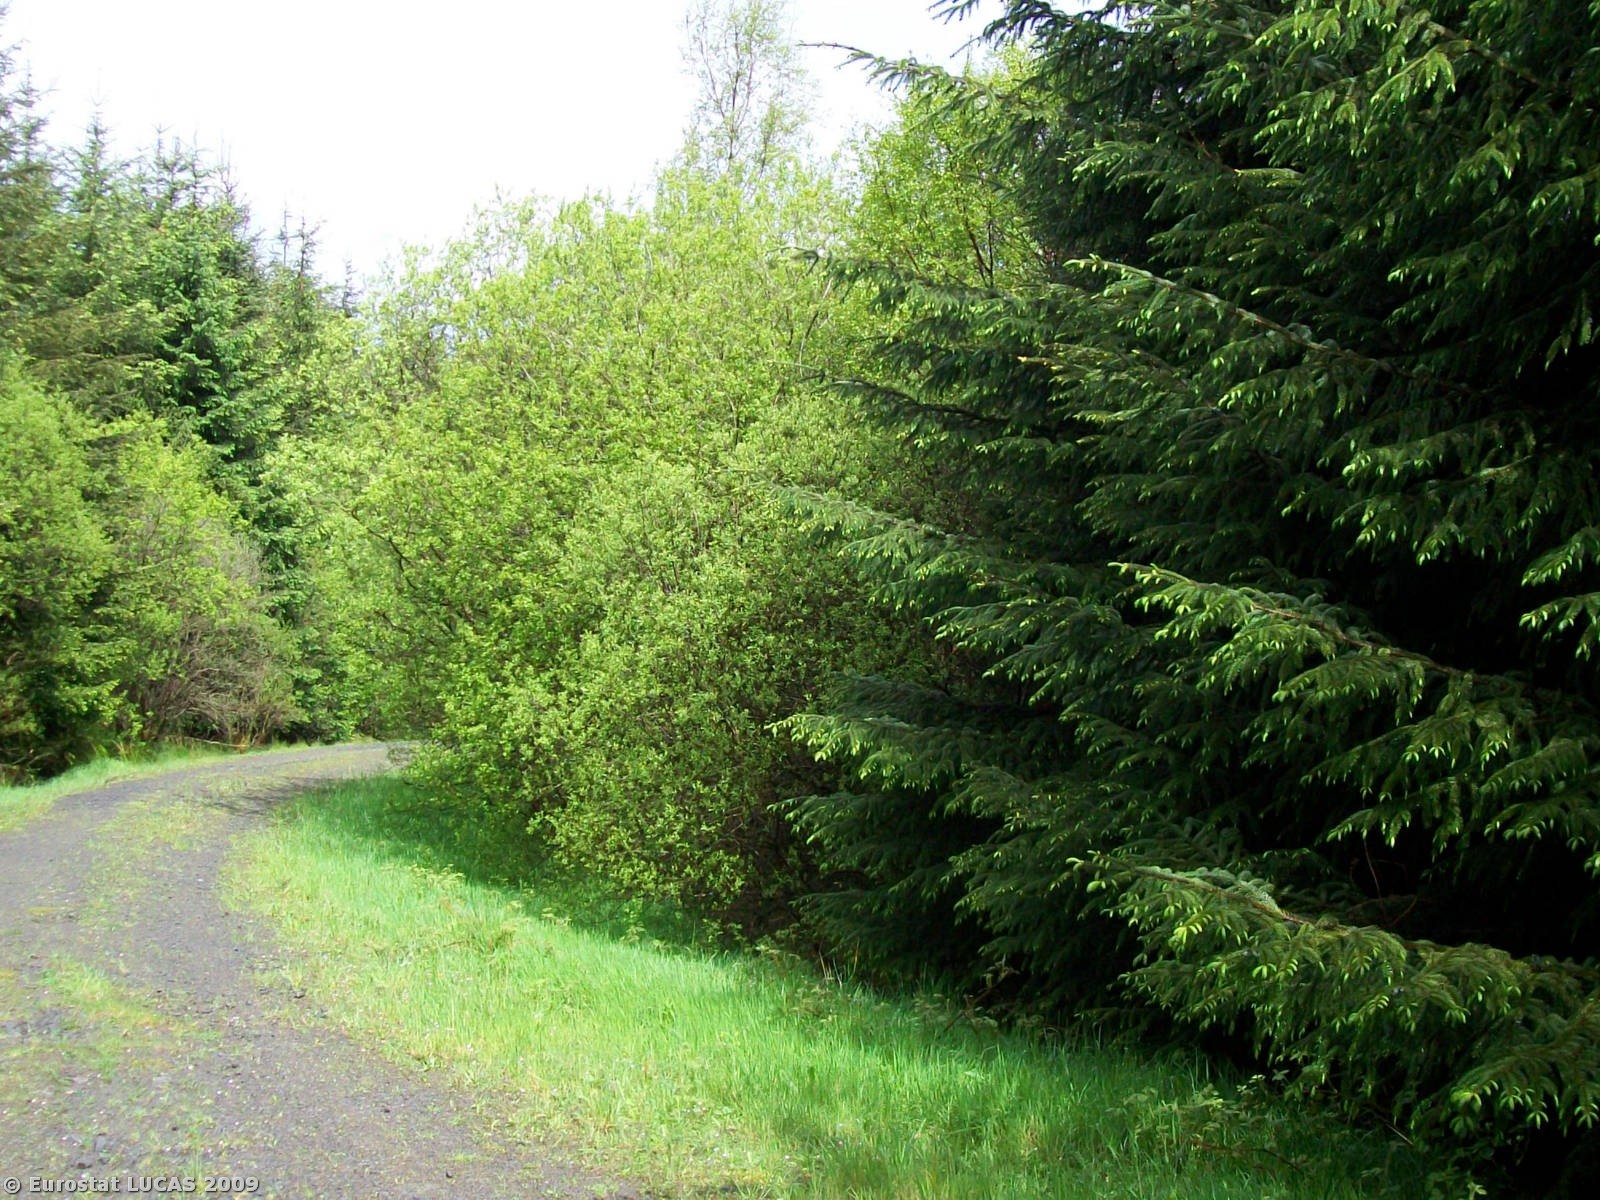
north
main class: Woodland
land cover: Coniferous woodland
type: plantations and self-sown exotic forest
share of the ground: > 75 %
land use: Forestry
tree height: > 5 m
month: May
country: GB
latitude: 51.9090
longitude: -3.6795
